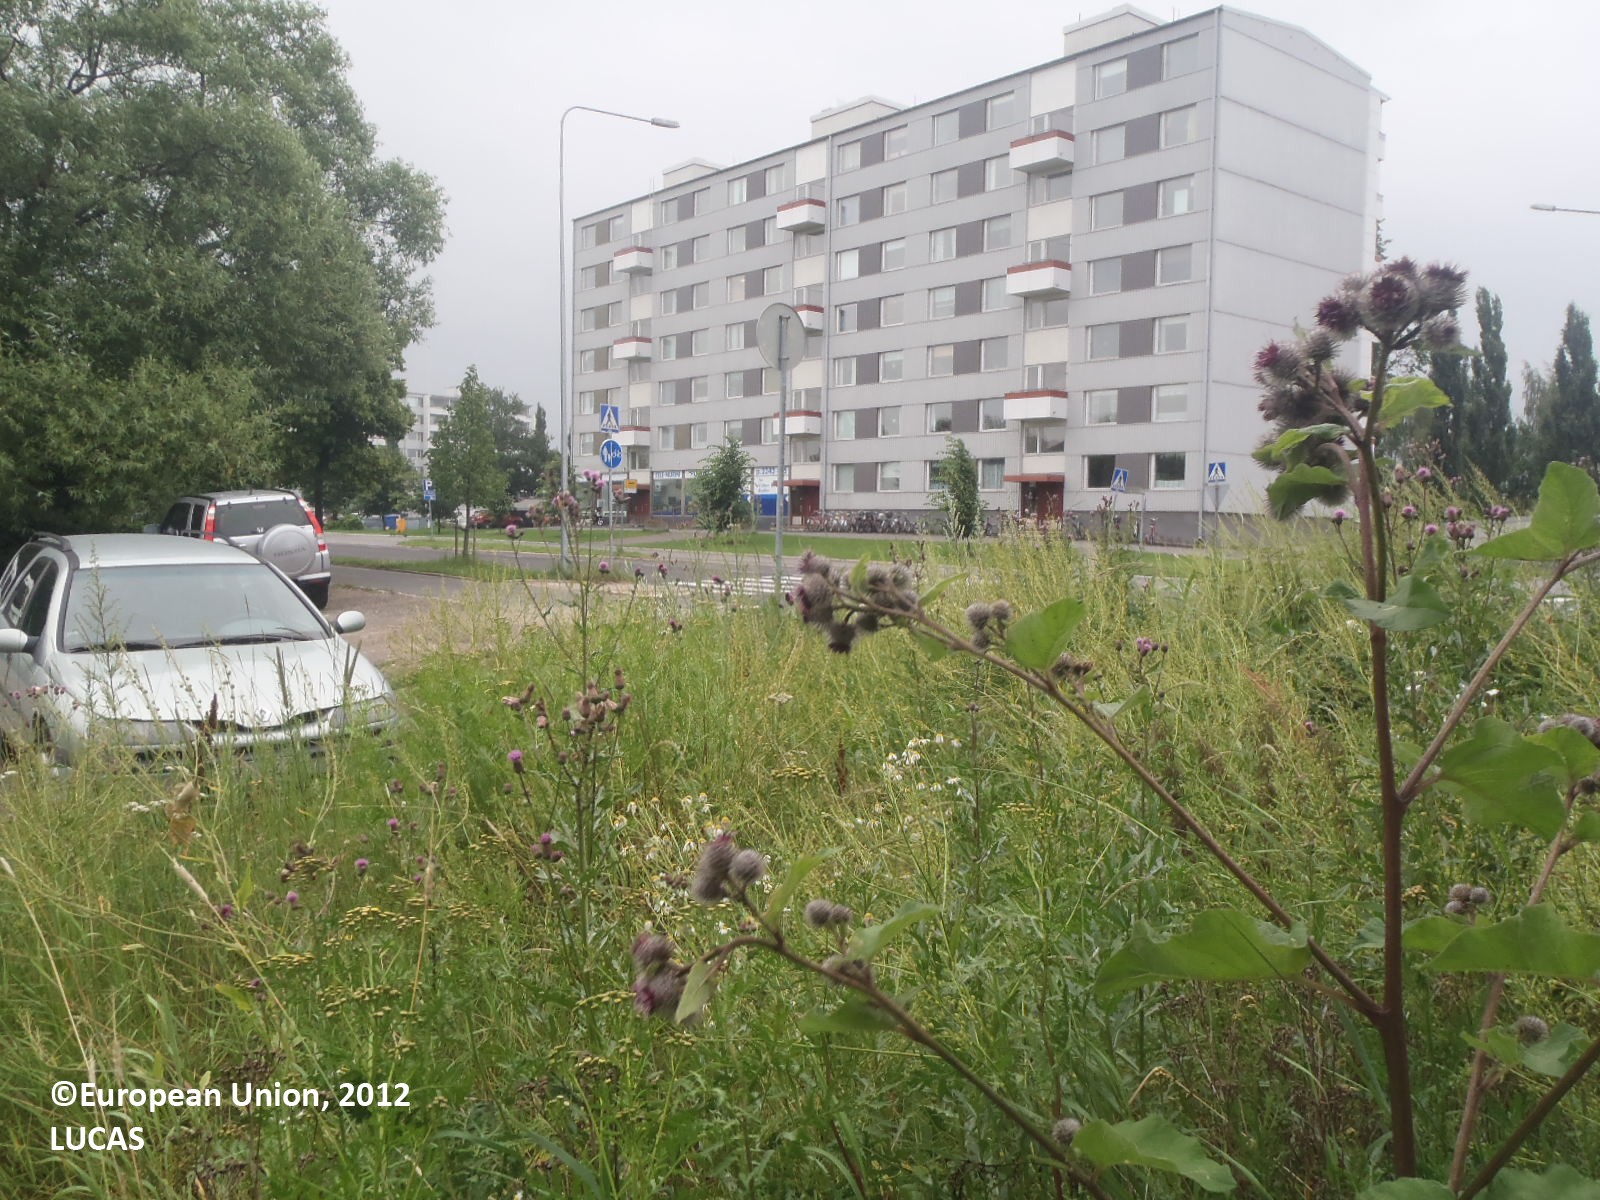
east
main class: Grassland
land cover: Grassland without tree/shrub cover
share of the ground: > 75 %
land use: Abandoned areas
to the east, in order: Grassland without tree/shrub cover; Artificial constructions in urban areas
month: July
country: FI
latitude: 60.4432
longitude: 22.2985
